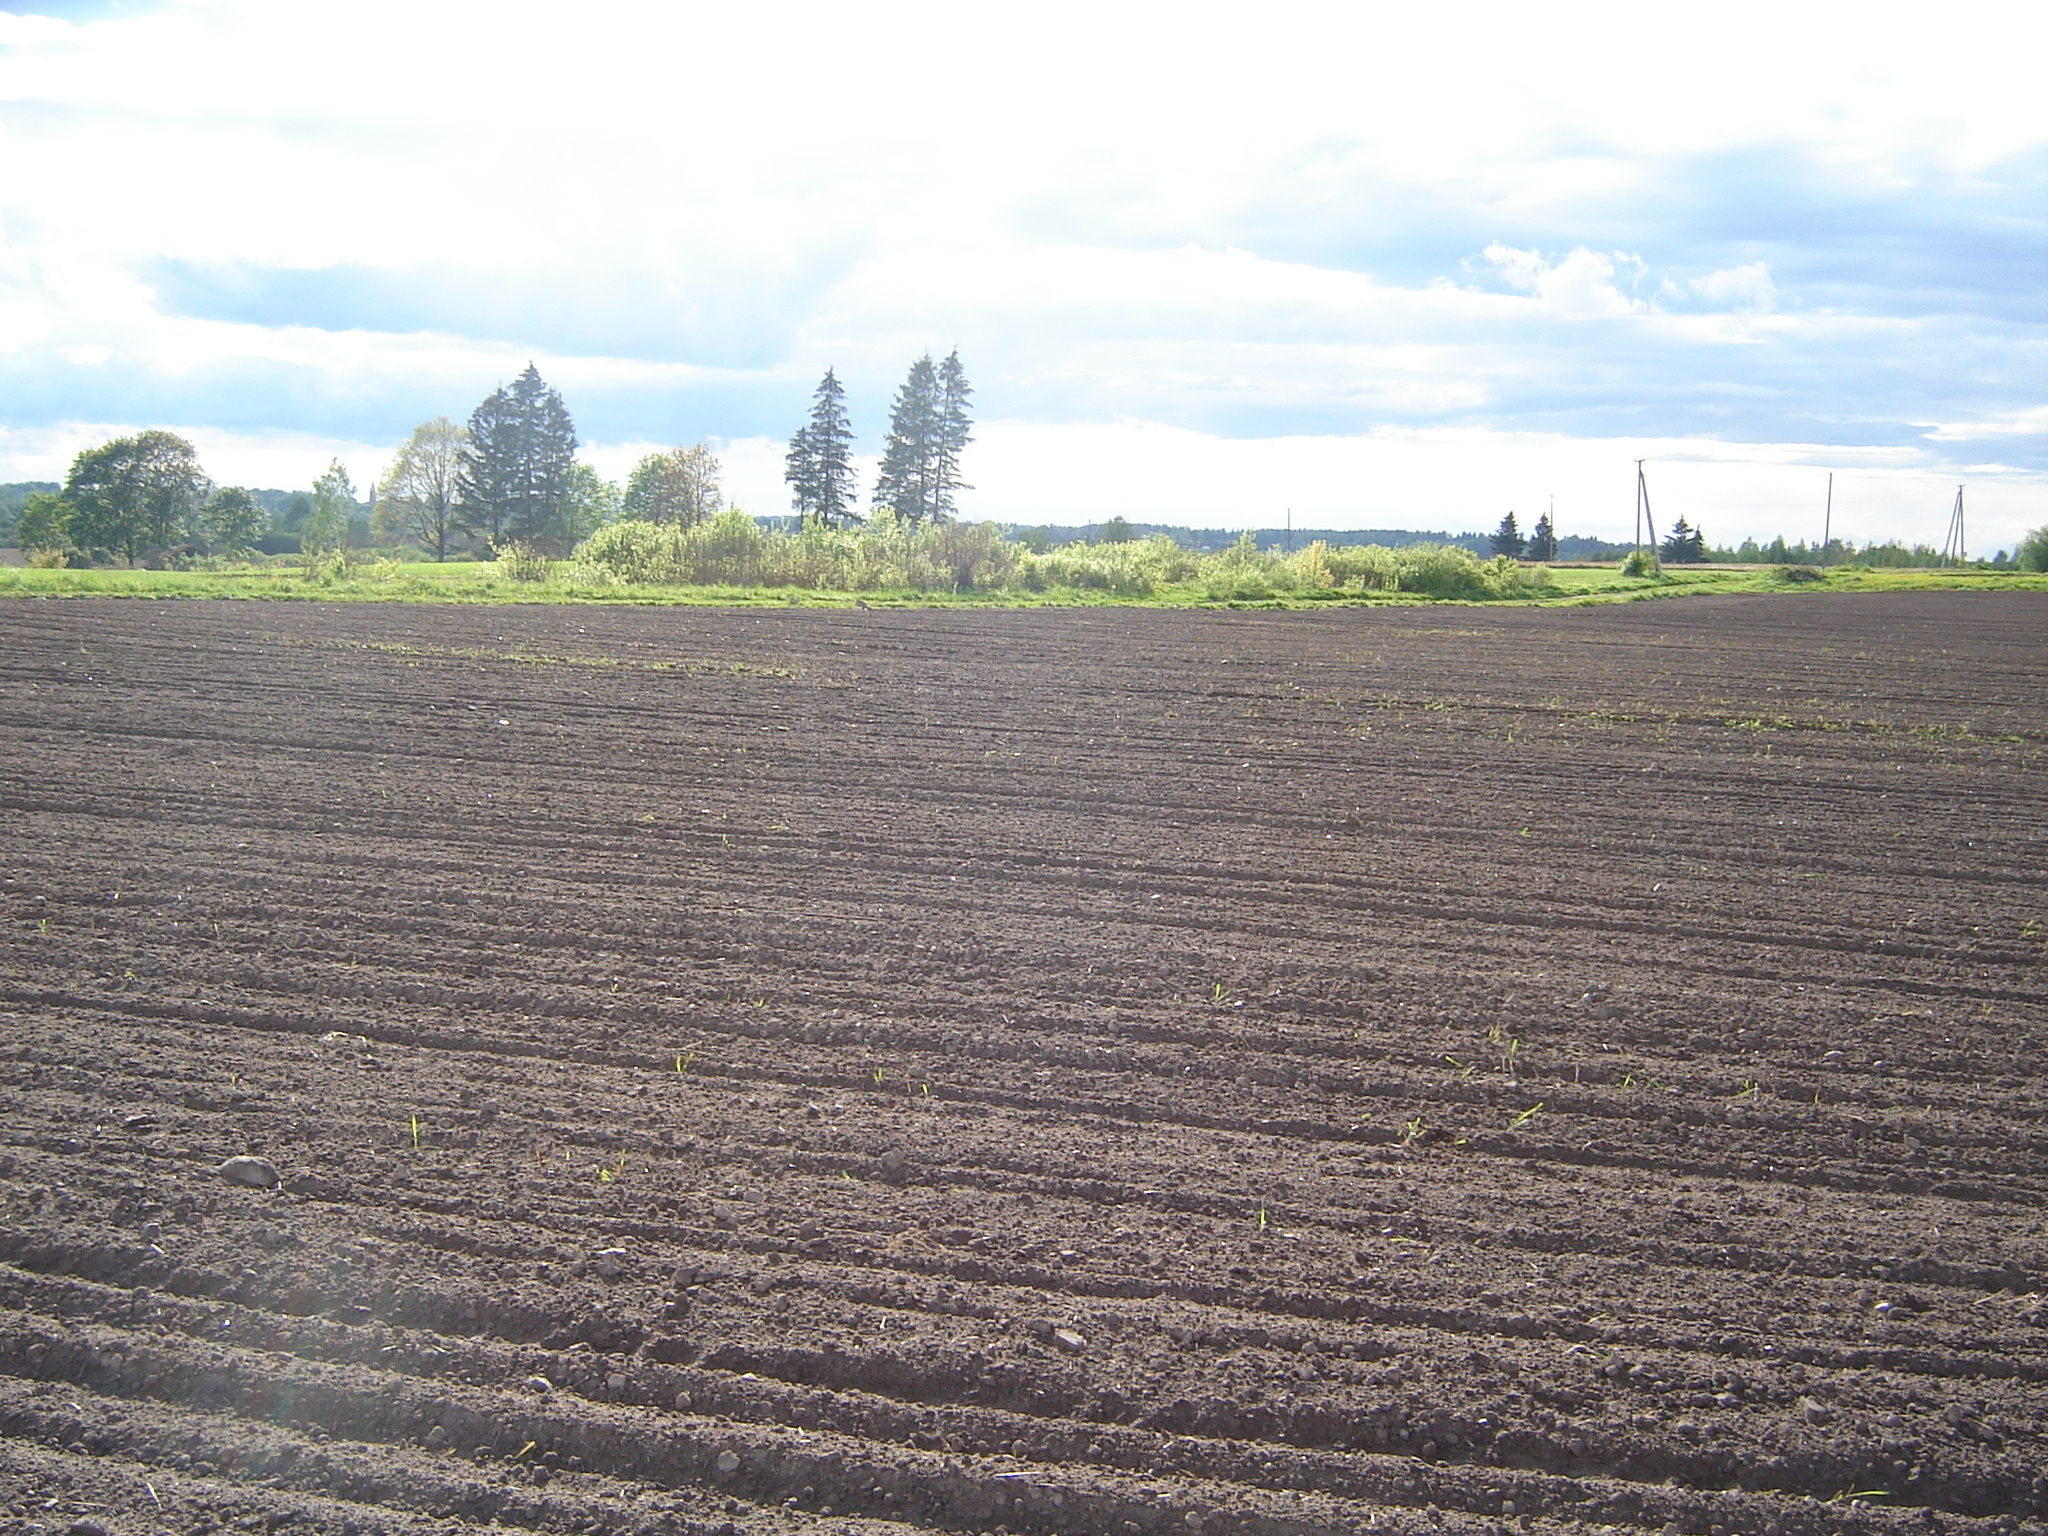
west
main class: Cropland
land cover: Oats
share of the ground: < 10 %
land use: Agriculture (excluding fallow land and kitchen gardens)
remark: Tilled/Sowed
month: May
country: LT
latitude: 56.0658
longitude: 25.3285
